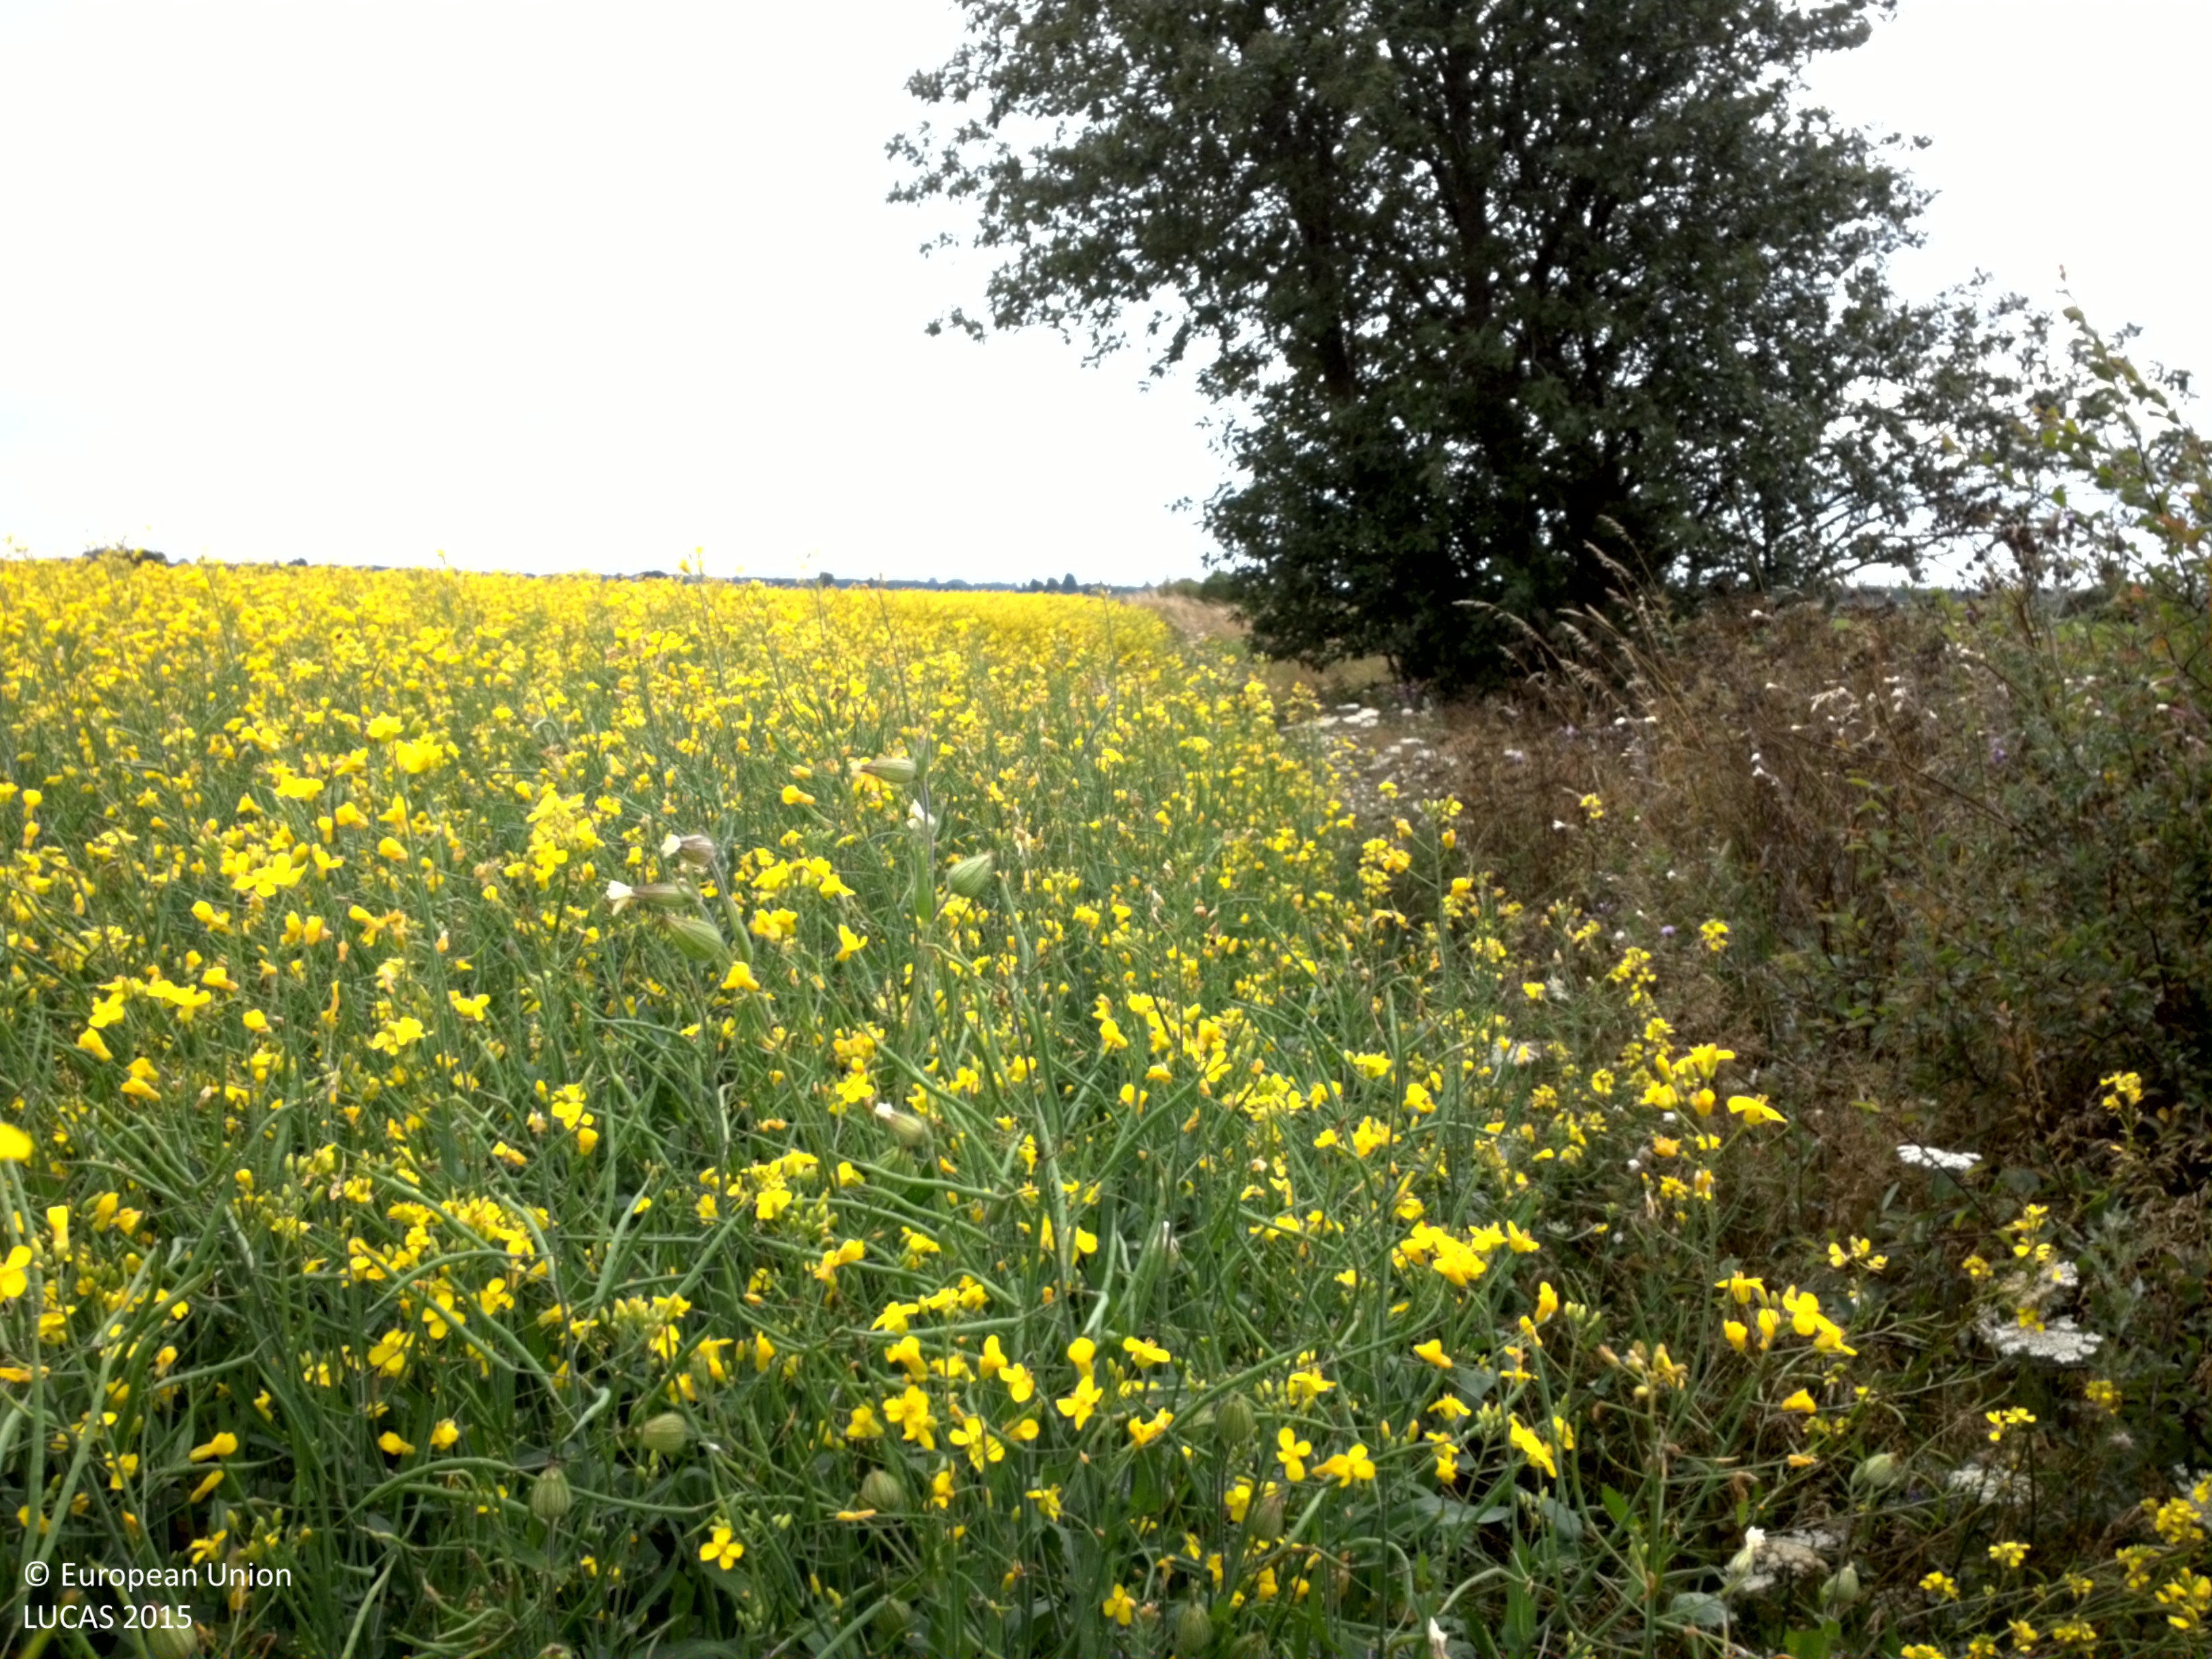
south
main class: Cropland
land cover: Rape and turnip rape
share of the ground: > 75 %
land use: Agriculture (excluding fallow land and kitchen gardens)
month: July
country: SE
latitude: 57.2478
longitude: 18.4448
